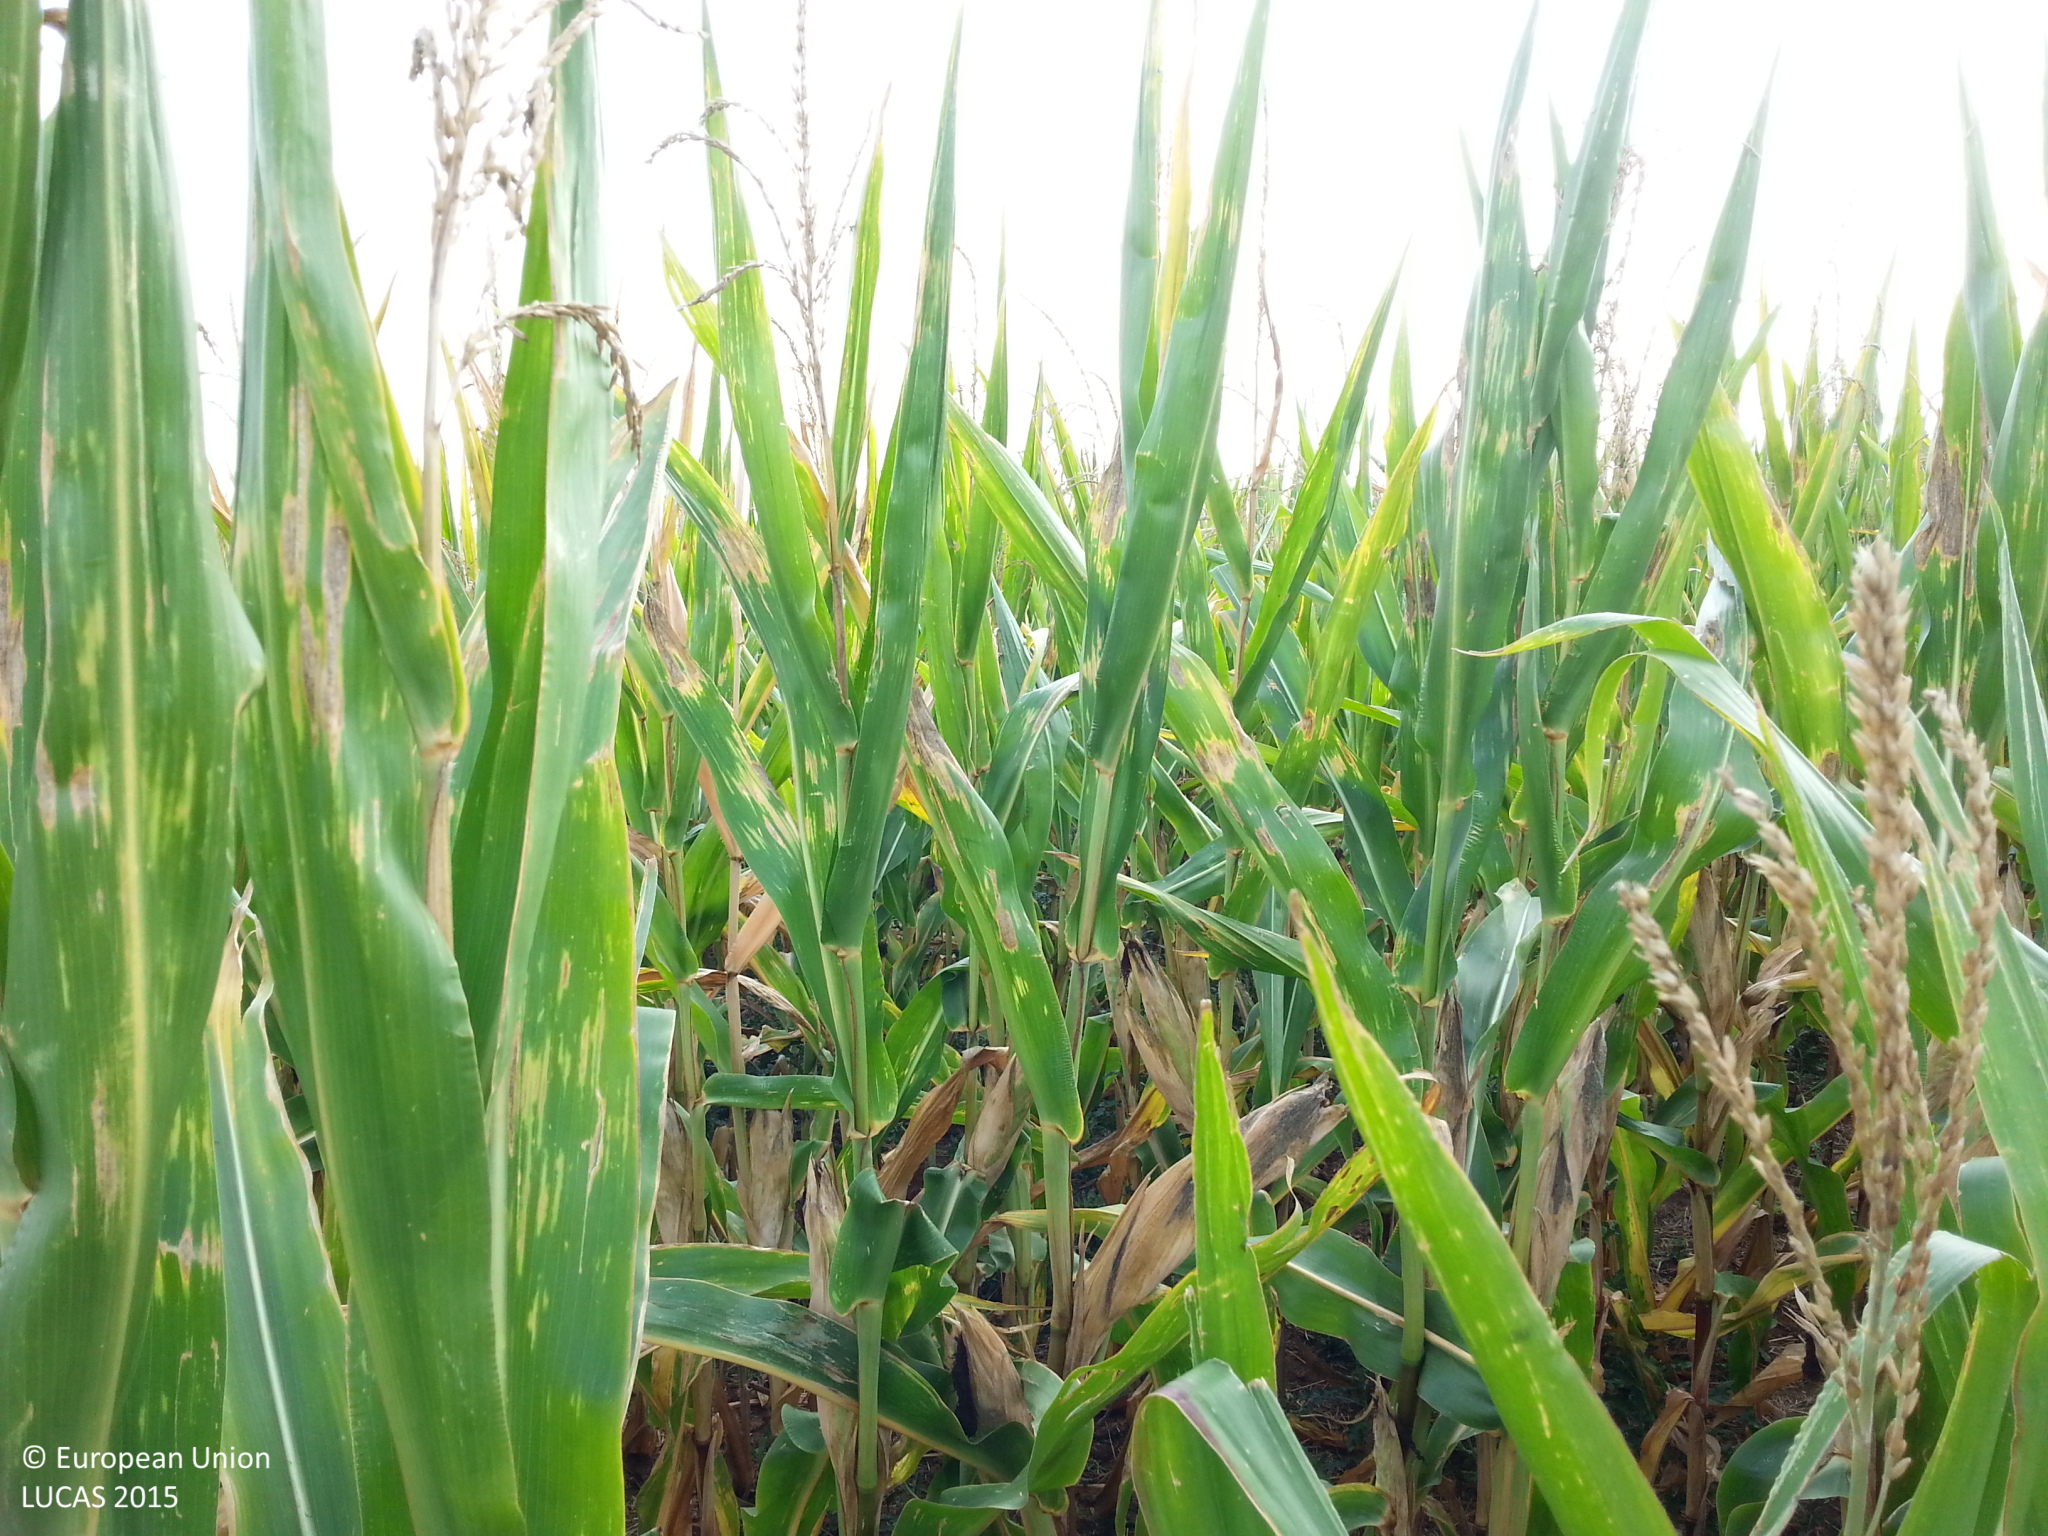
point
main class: Cropland
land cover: Maize
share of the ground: > 75 %
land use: Agriculture (excluding fallow land and kitchen gardens)
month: September
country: DE
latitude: 49.3569
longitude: 9.9587
